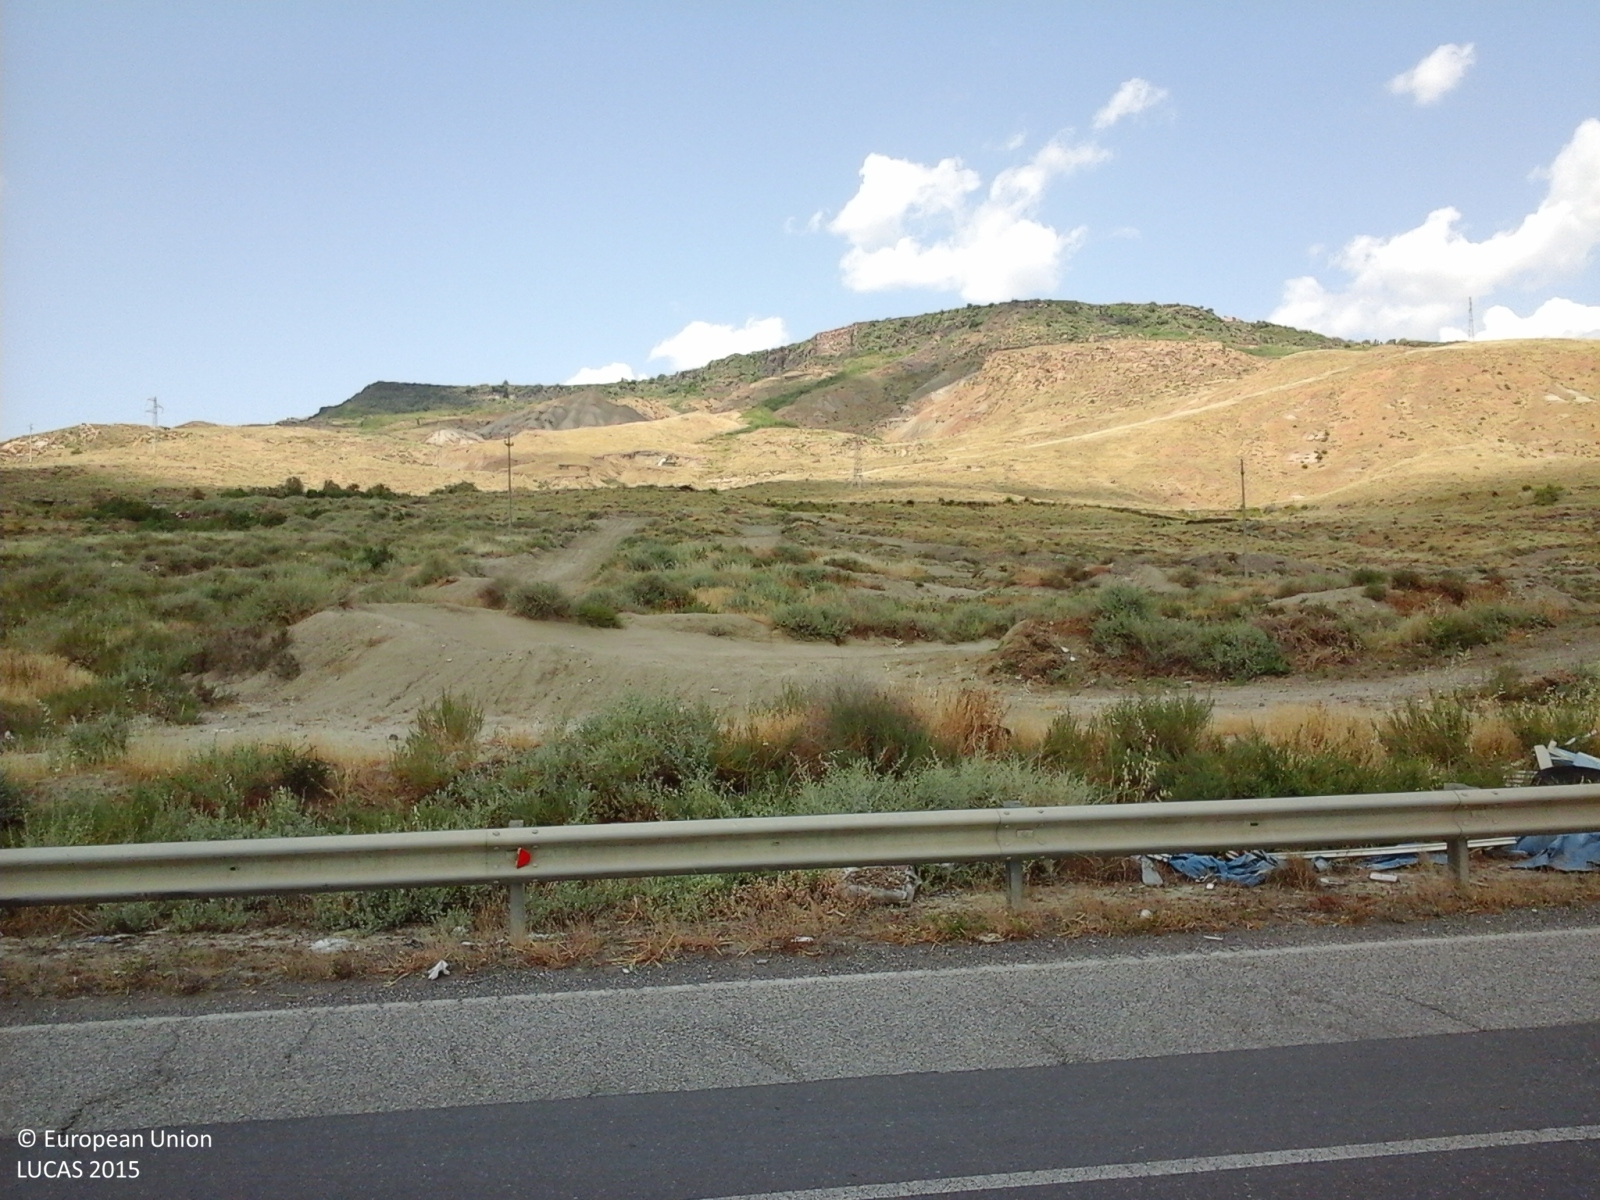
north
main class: Grassland
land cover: Grassland without tree/shrub cover
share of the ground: > 75 %
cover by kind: herbaceous plants 100 %
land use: Agriculture (excluding fallow land and kitchen gardens)
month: May
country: IT
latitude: 37.6431
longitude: 14.8277
